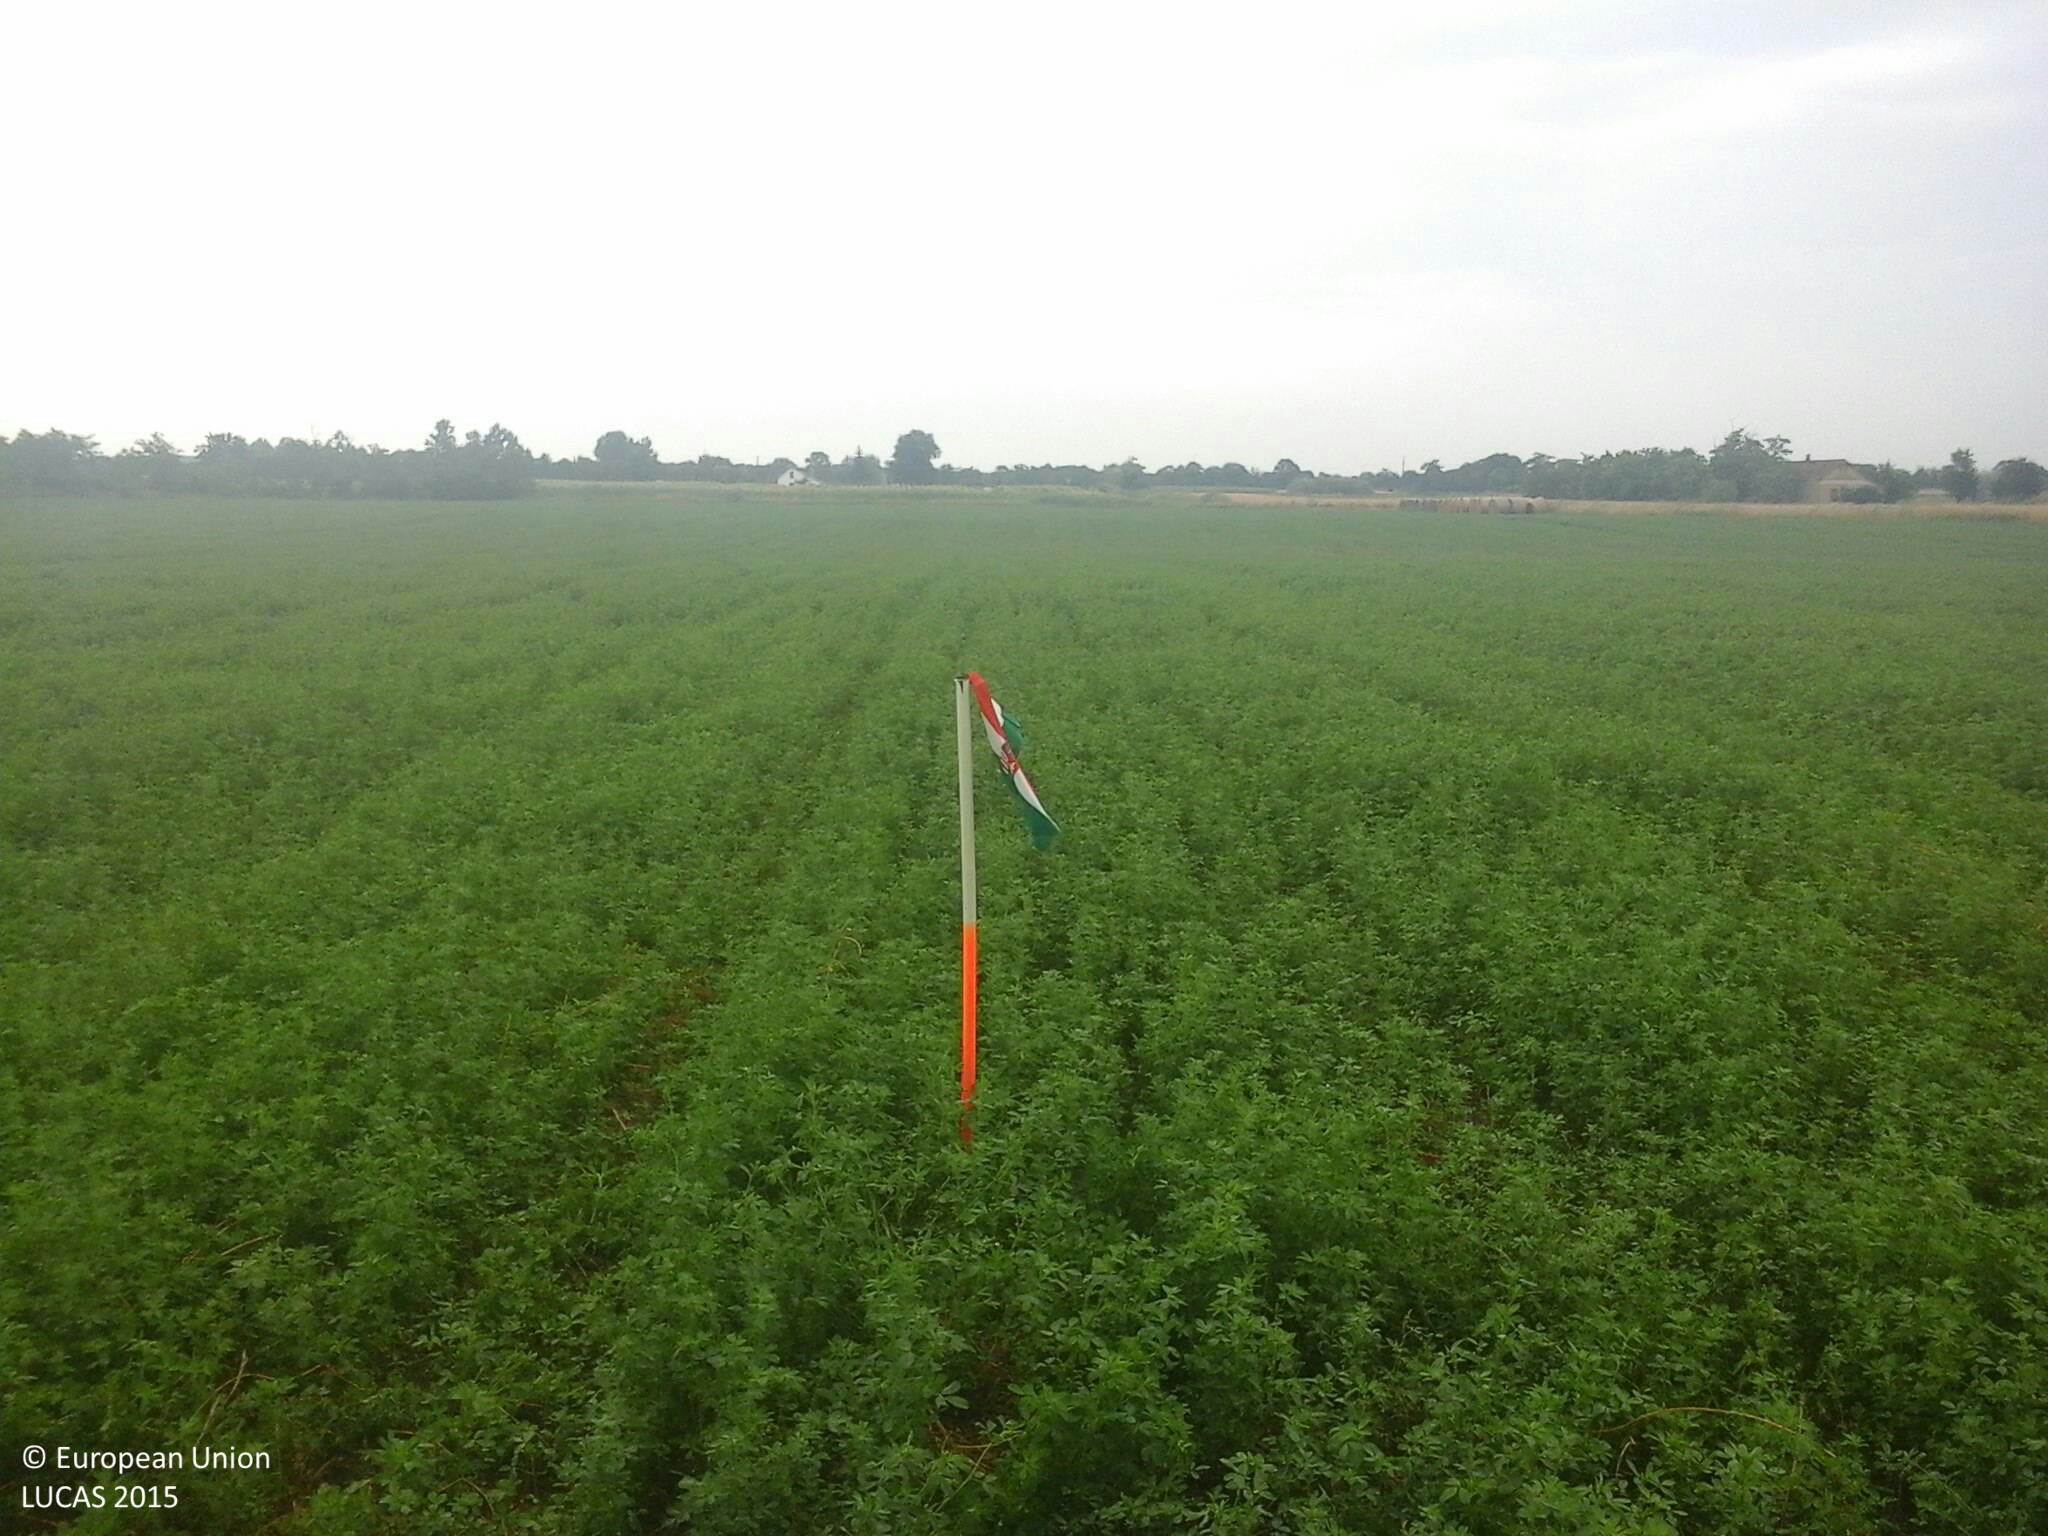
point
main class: Cropland
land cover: Lucerne
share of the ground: > 75 %
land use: Agriculture (excluding fallow land and kitchen gardens)
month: July
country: HU
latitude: 46.6831
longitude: 20.1565
